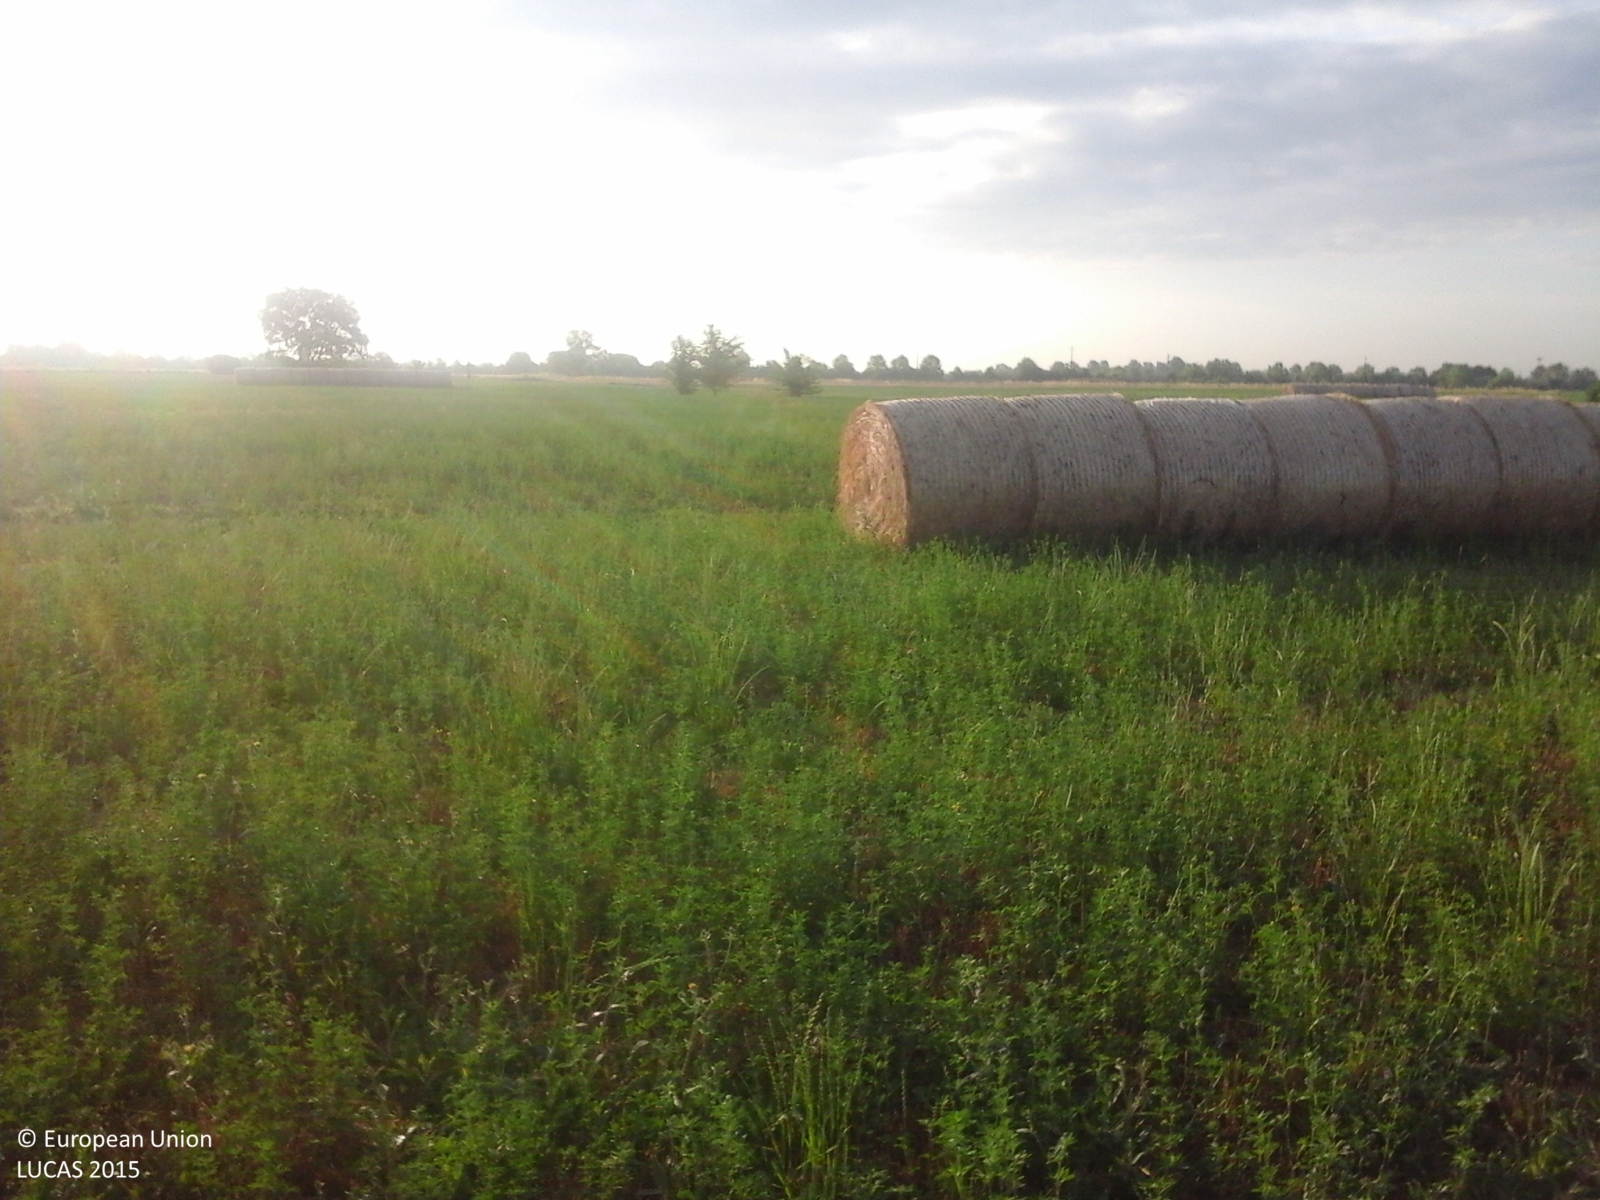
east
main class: Cropland
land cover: Lucerne
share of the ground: > 75 %
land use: Agriculture (excluding fallow land and kitchen gardens)
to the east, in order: Lucerne; Ditches and canals; Lucerne; Ditches and canals; Lucerne; Ditches and canals; Lucerne; Ditches and canals; Lucerne; Ditches and canals; Lucerne; Ditches and canals; Lucerne; Ditches and canals; Lucerne; Ditches and canals; Lucerne; Ditches and canals; Lucerne; Ditches and canals; Lucerne; Electric lines; Lucerne; Ditches and canals; Grass margins; Artificial constructions; Grass margins; Rape and turnip rape
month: June
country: IT
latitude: 44.9406
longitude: 11.0245
